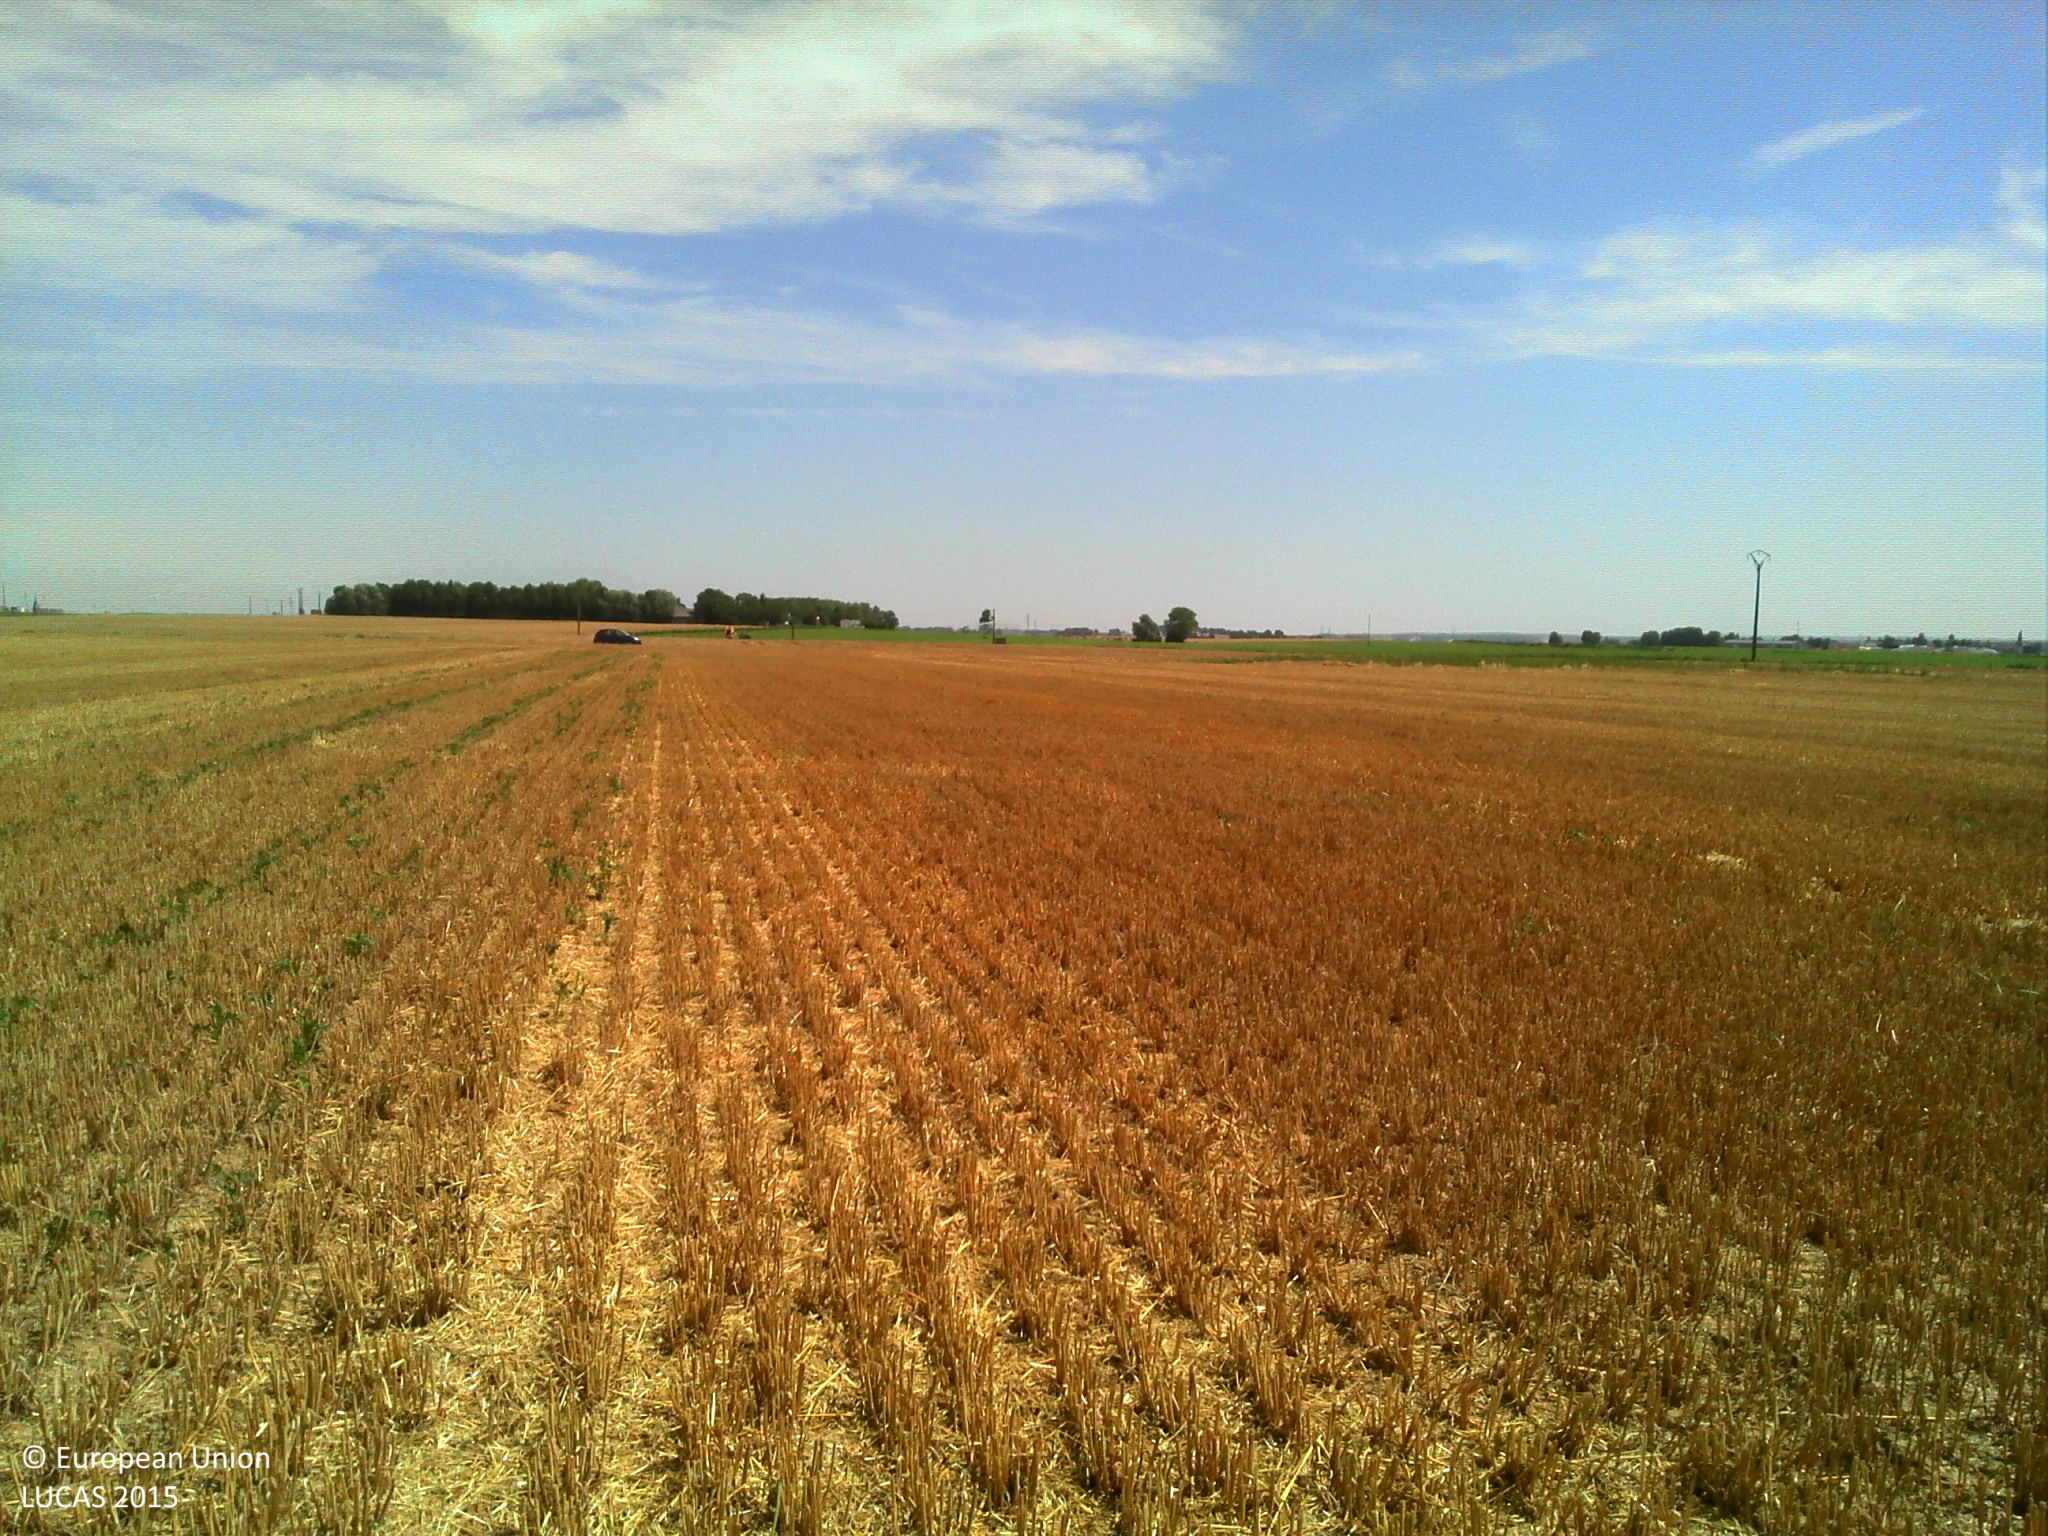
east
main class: Cropland
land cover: Common wheat
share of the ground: > 75 %
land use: Agriculture (excluding fallow land and kitchen gardens)
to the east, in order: Common wheat; Grass margins; Tracks; Grass margins; Common wheat
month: August
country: FR
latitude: 49.7068
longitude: 2.8483
